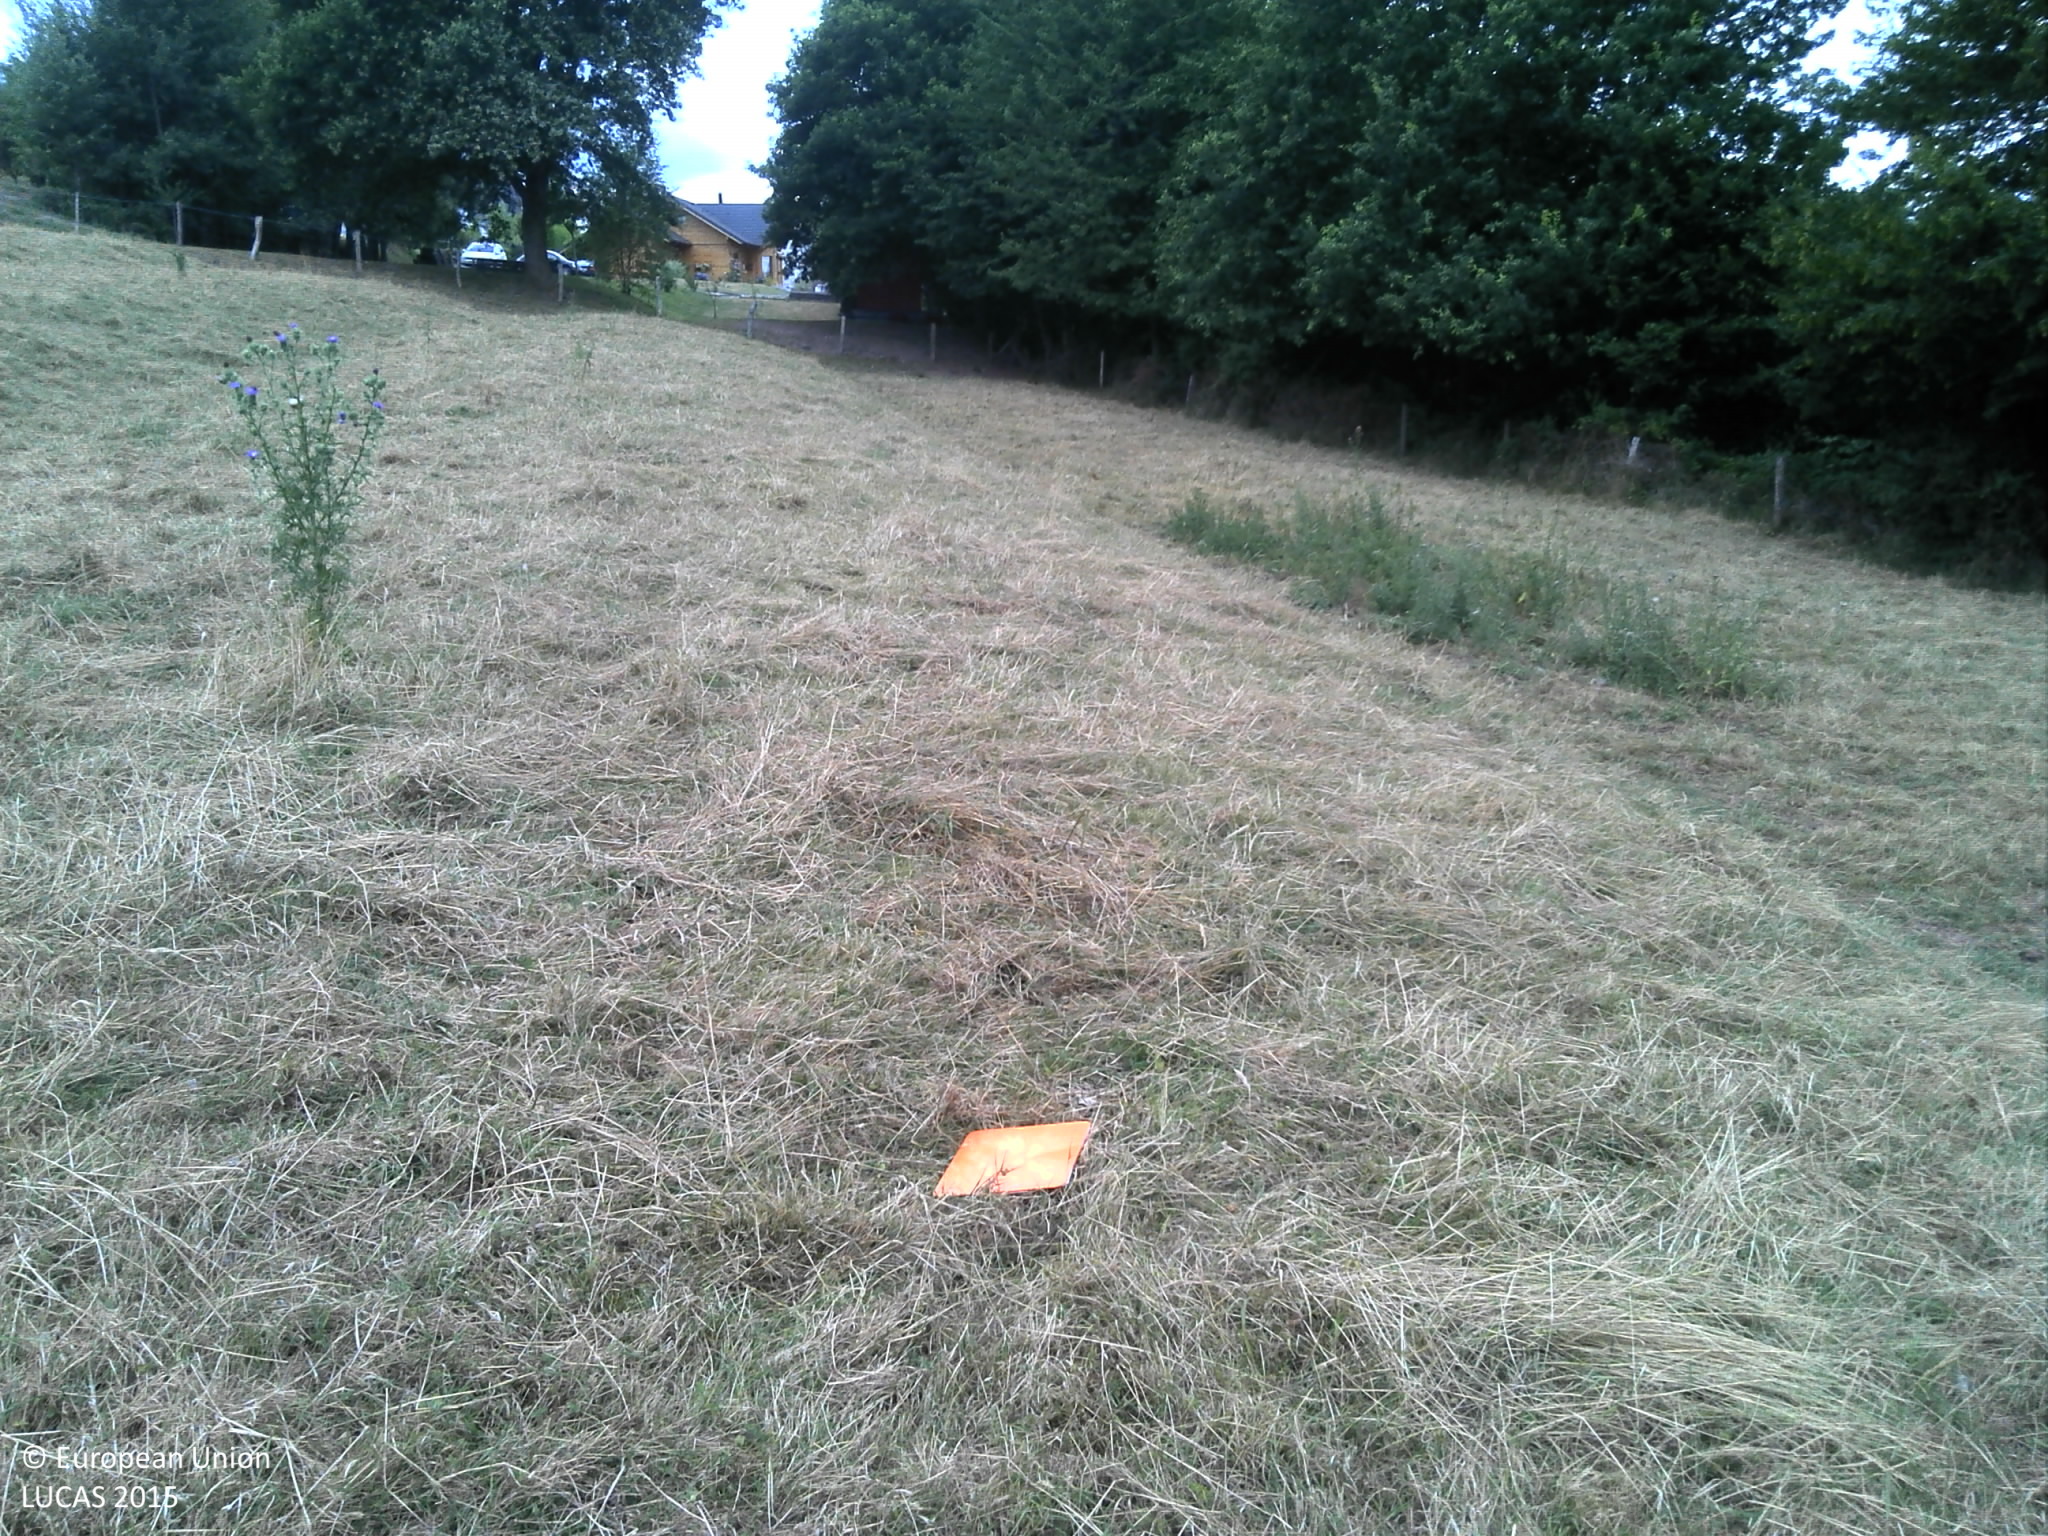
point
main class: Grassland
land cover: Grassland without tree/shrub cover
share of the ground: > 75 %
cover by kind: herbaceous plants 100 %
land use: Agriculture (excluding fallow land and kitchen gardens)
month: July
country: FR
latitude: 48.7478
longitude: 7.2670
